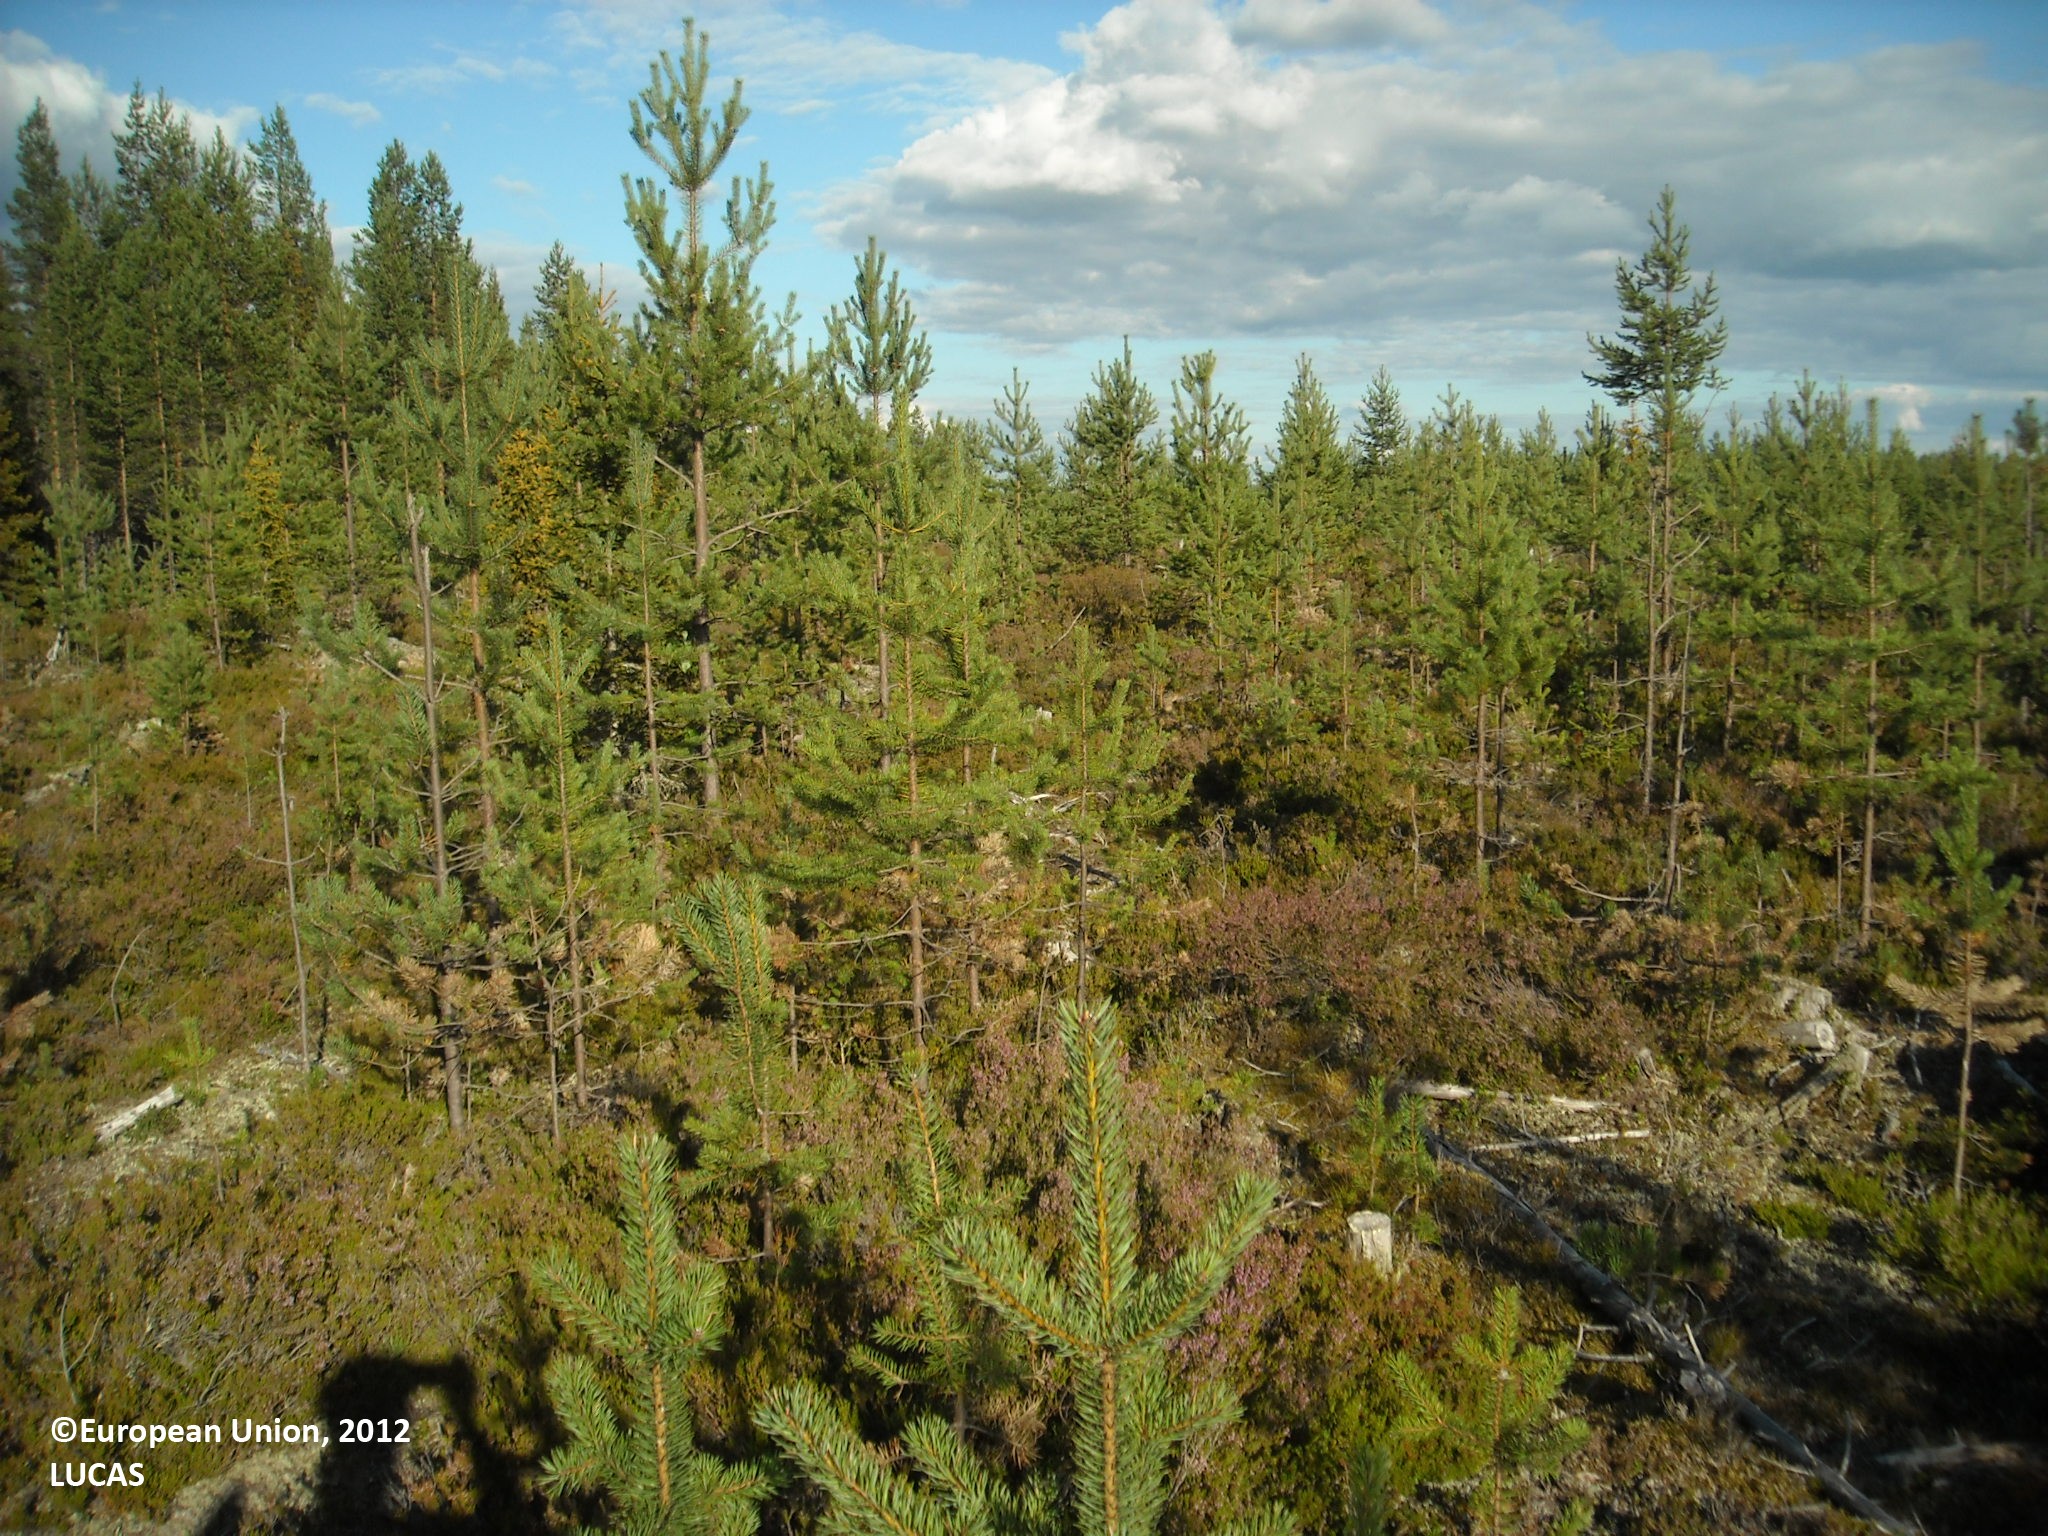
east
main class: Woodland
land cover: Pine dominated coniferous woodland
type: boreal forest
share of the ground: 25 - 50 %
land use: Forestry
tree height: < 5 m
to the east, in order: Pine dominated coniferous woodland; Other coniferous woodland; Pine dominated coniferous woodland
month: August
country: FI
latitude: 65.5167
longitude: 27.8508
